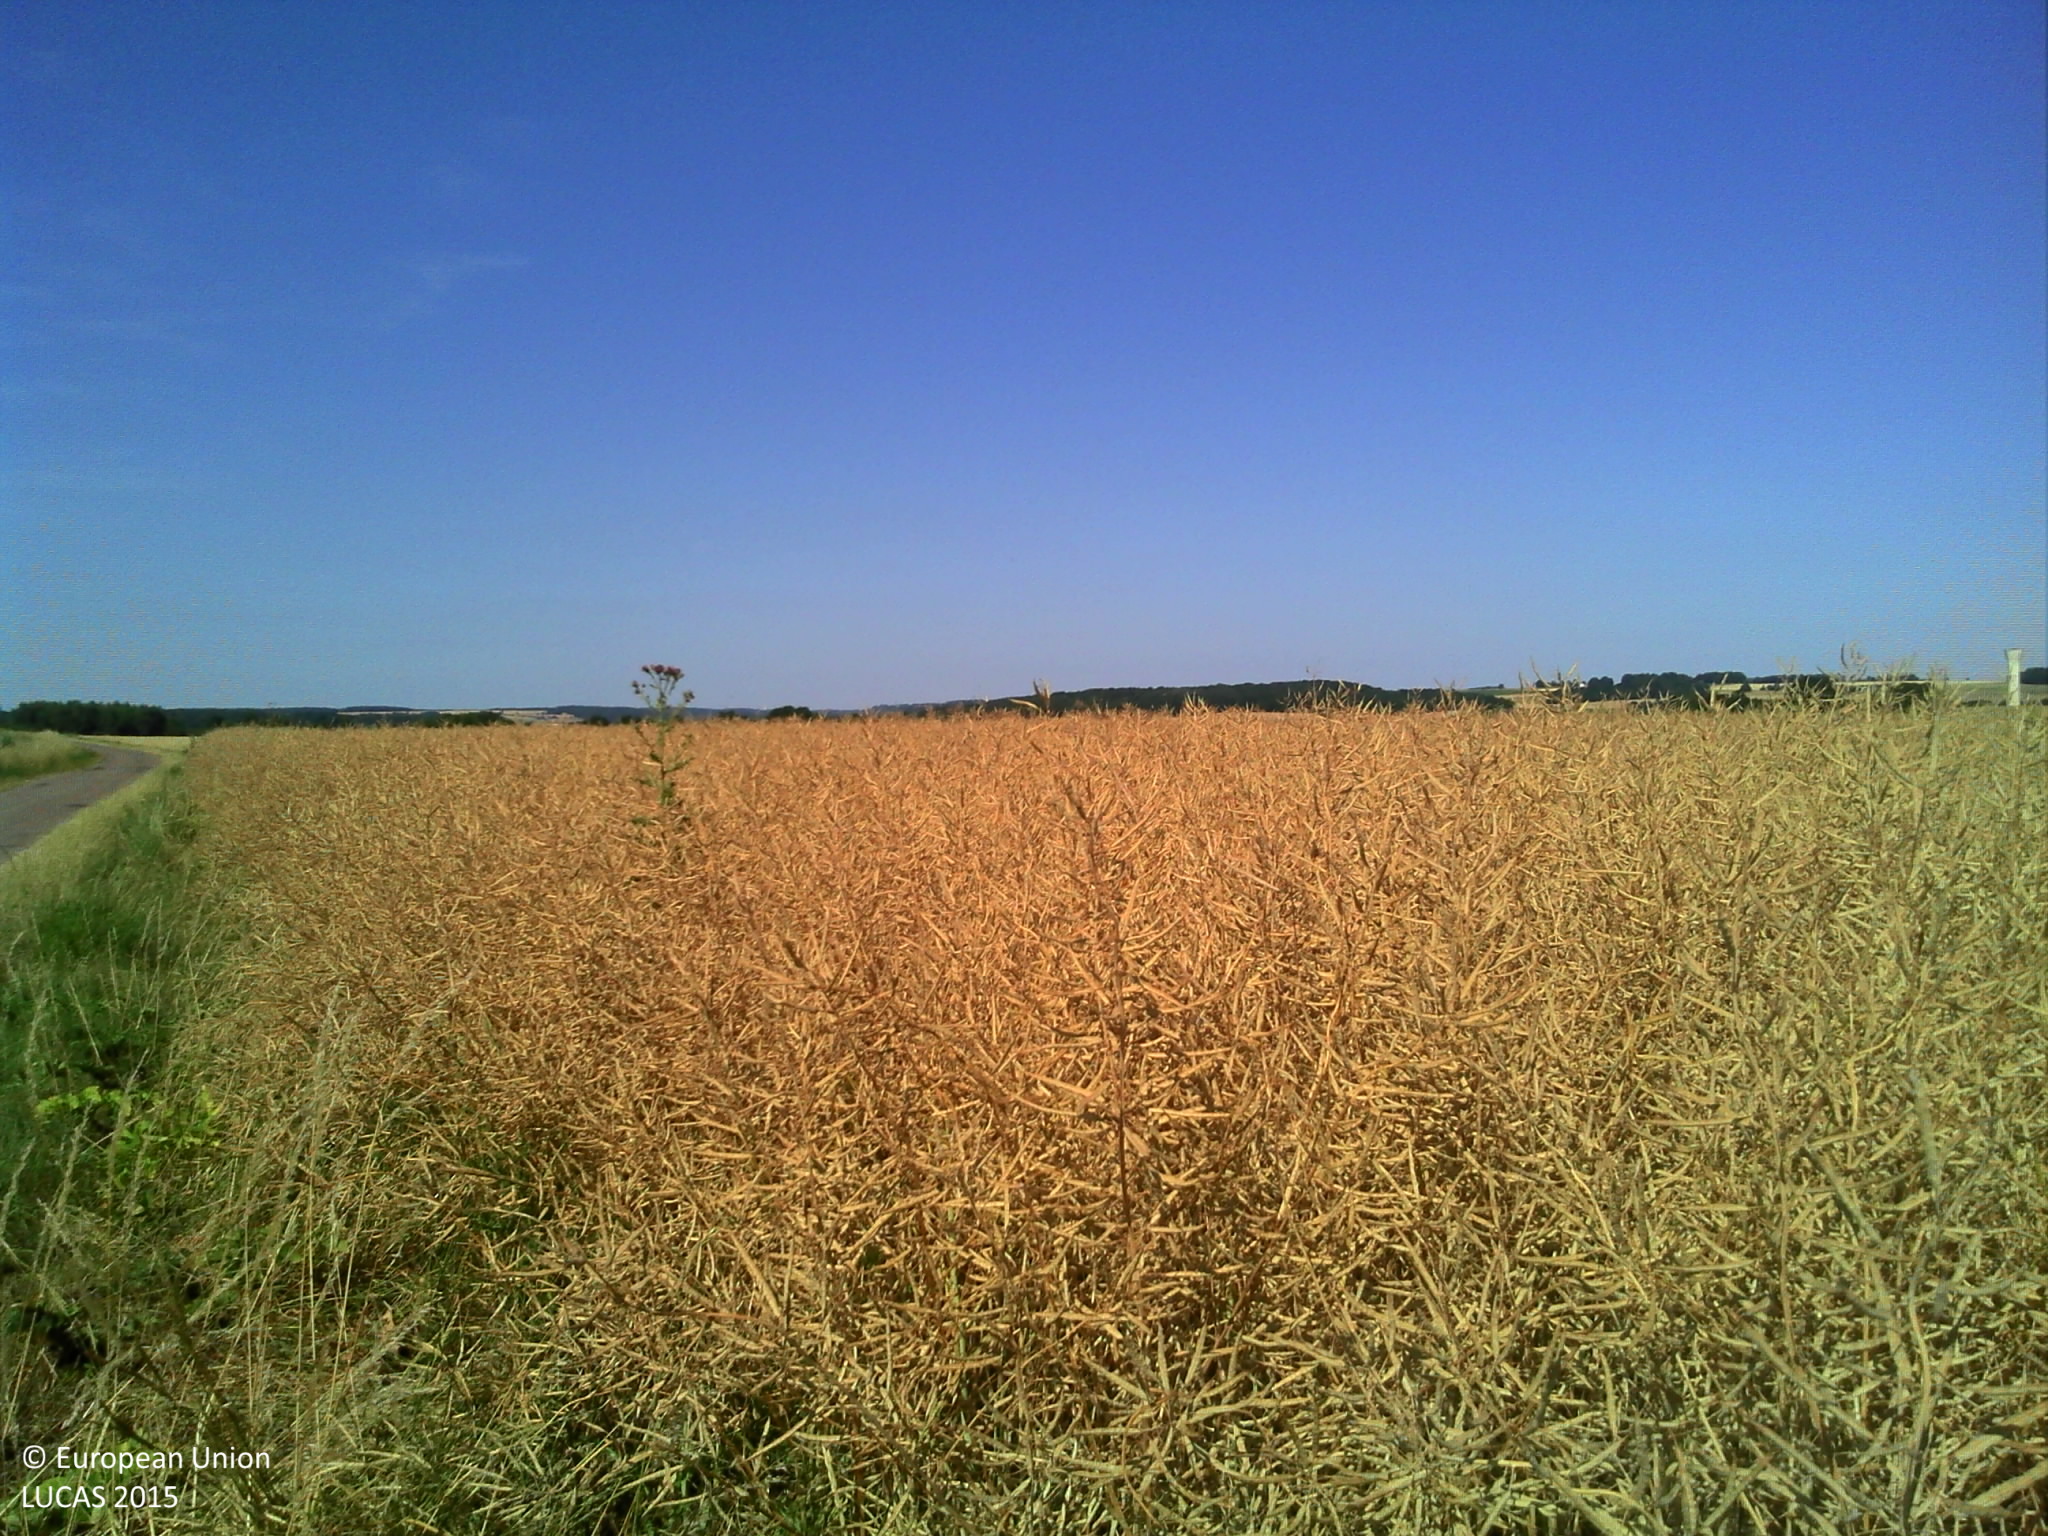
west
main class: Cropland
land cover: Rape and turnip rape
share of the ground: > 75 %
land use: Agriculture (excluding fallow land and kitchen gardens)
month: July
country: FR
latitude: 47.9512
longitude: 3.0707
